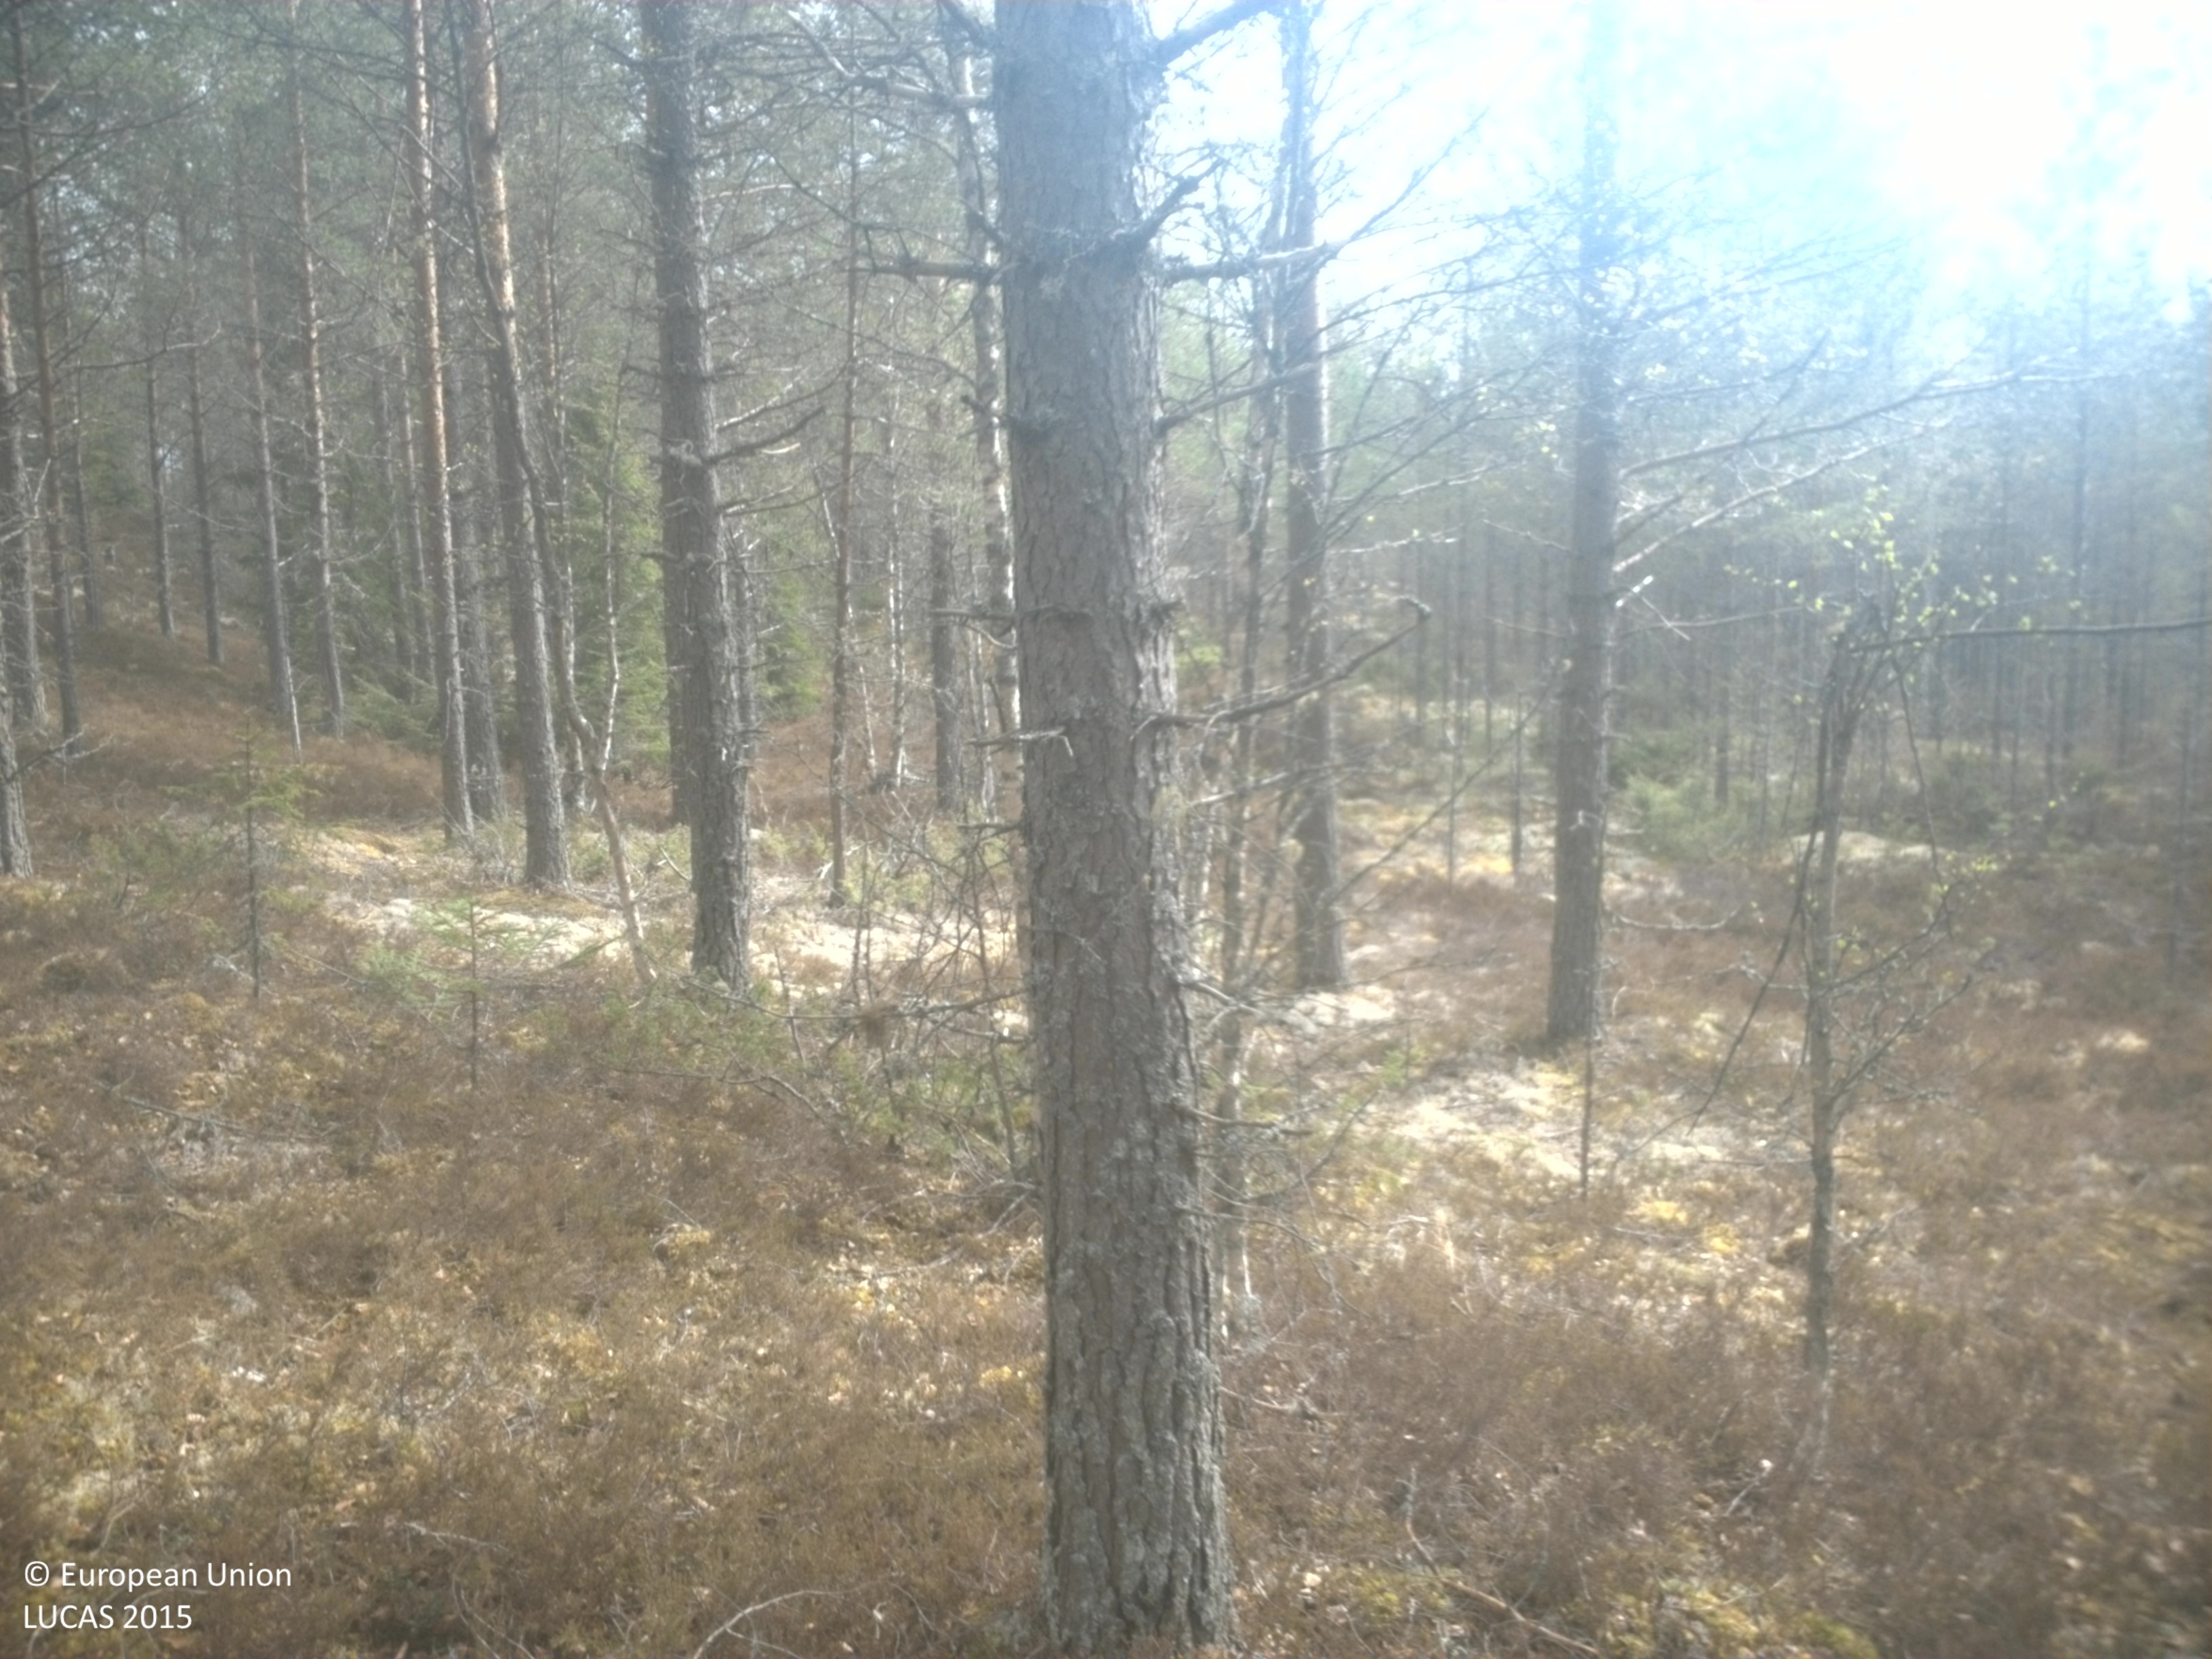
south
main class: Woodland
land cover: Pine dominated coniferous woodland
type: boreal forest
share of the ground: 50 - 75 %
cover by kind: coniferous forest trees 70 %, shrubs 20 %, lichens and mosses 10 %
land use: Forestry
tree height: > 5 m
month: June
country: SE
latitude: 61.0422
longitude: 13.3401
